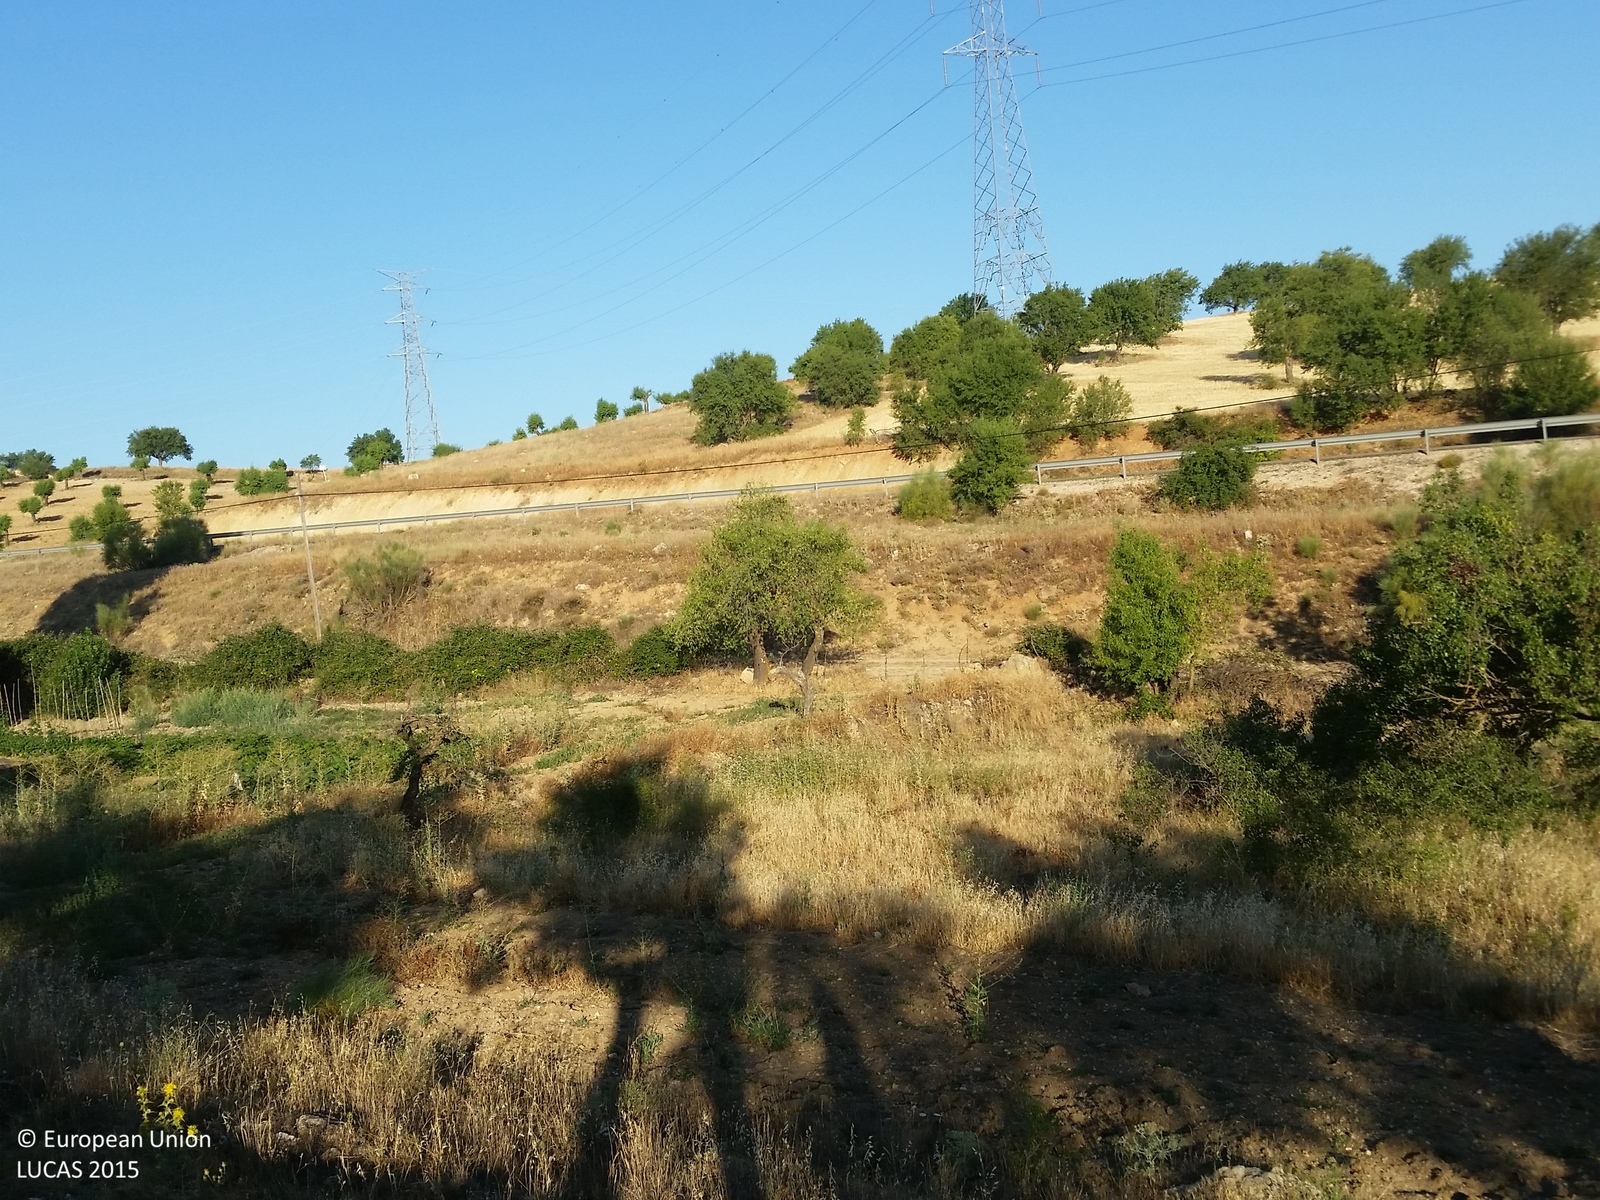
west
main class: Cropland
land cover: Nuts trees
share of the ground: > 75 %
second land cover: Grassland without tree/shrub cover
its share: 25 - 50 %
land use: Agriculture (excluding fallow land and kitchen gardens)
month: July
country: ES
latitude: 38.9669
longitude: -2.5278
